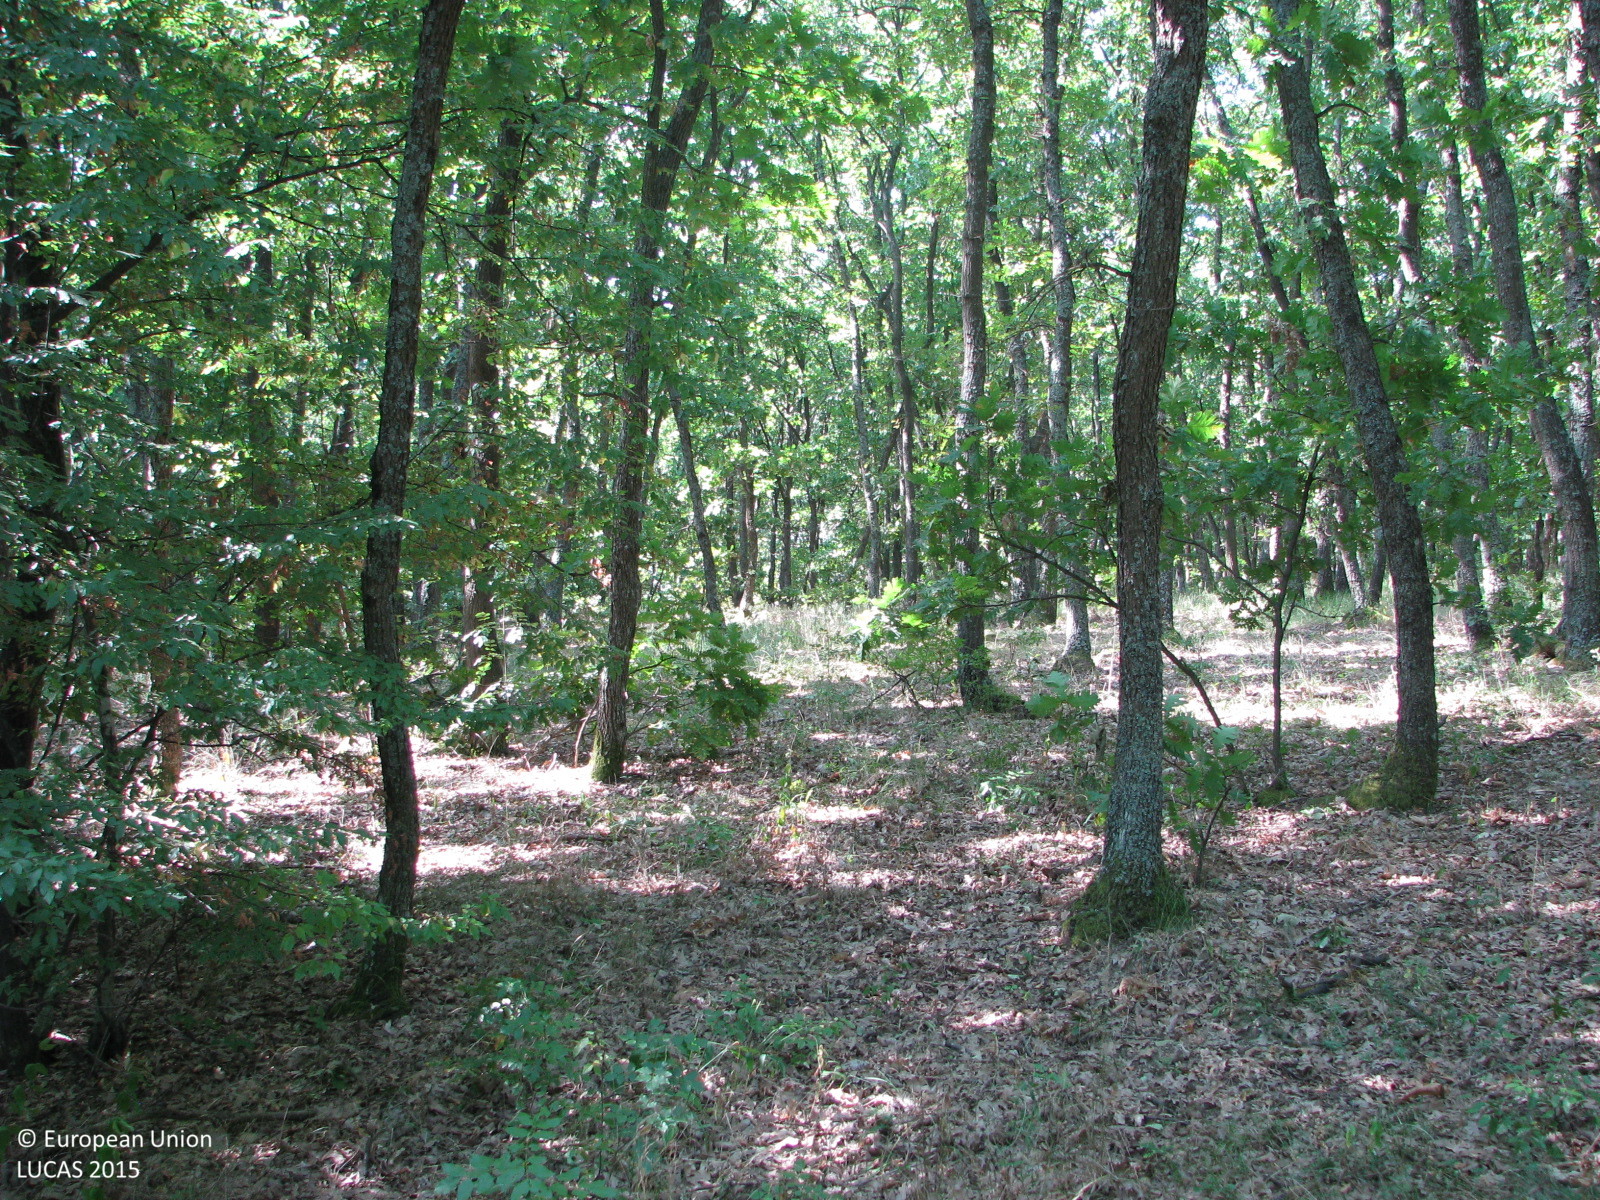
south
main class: Woodland
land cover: Broadleaved woodland
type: acidophilous oak and oak-birch forest
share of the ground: 50 - 75 %
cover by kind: broadleaved forest trees 55 %, consolidated bare surface 30 %, shrubs 5 %, herbaceous plants 5 %, lichens and mosses 5 %
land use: Forestry
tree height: > 5 m
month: August
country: BG
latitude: 42.6933
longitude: 26.6876
